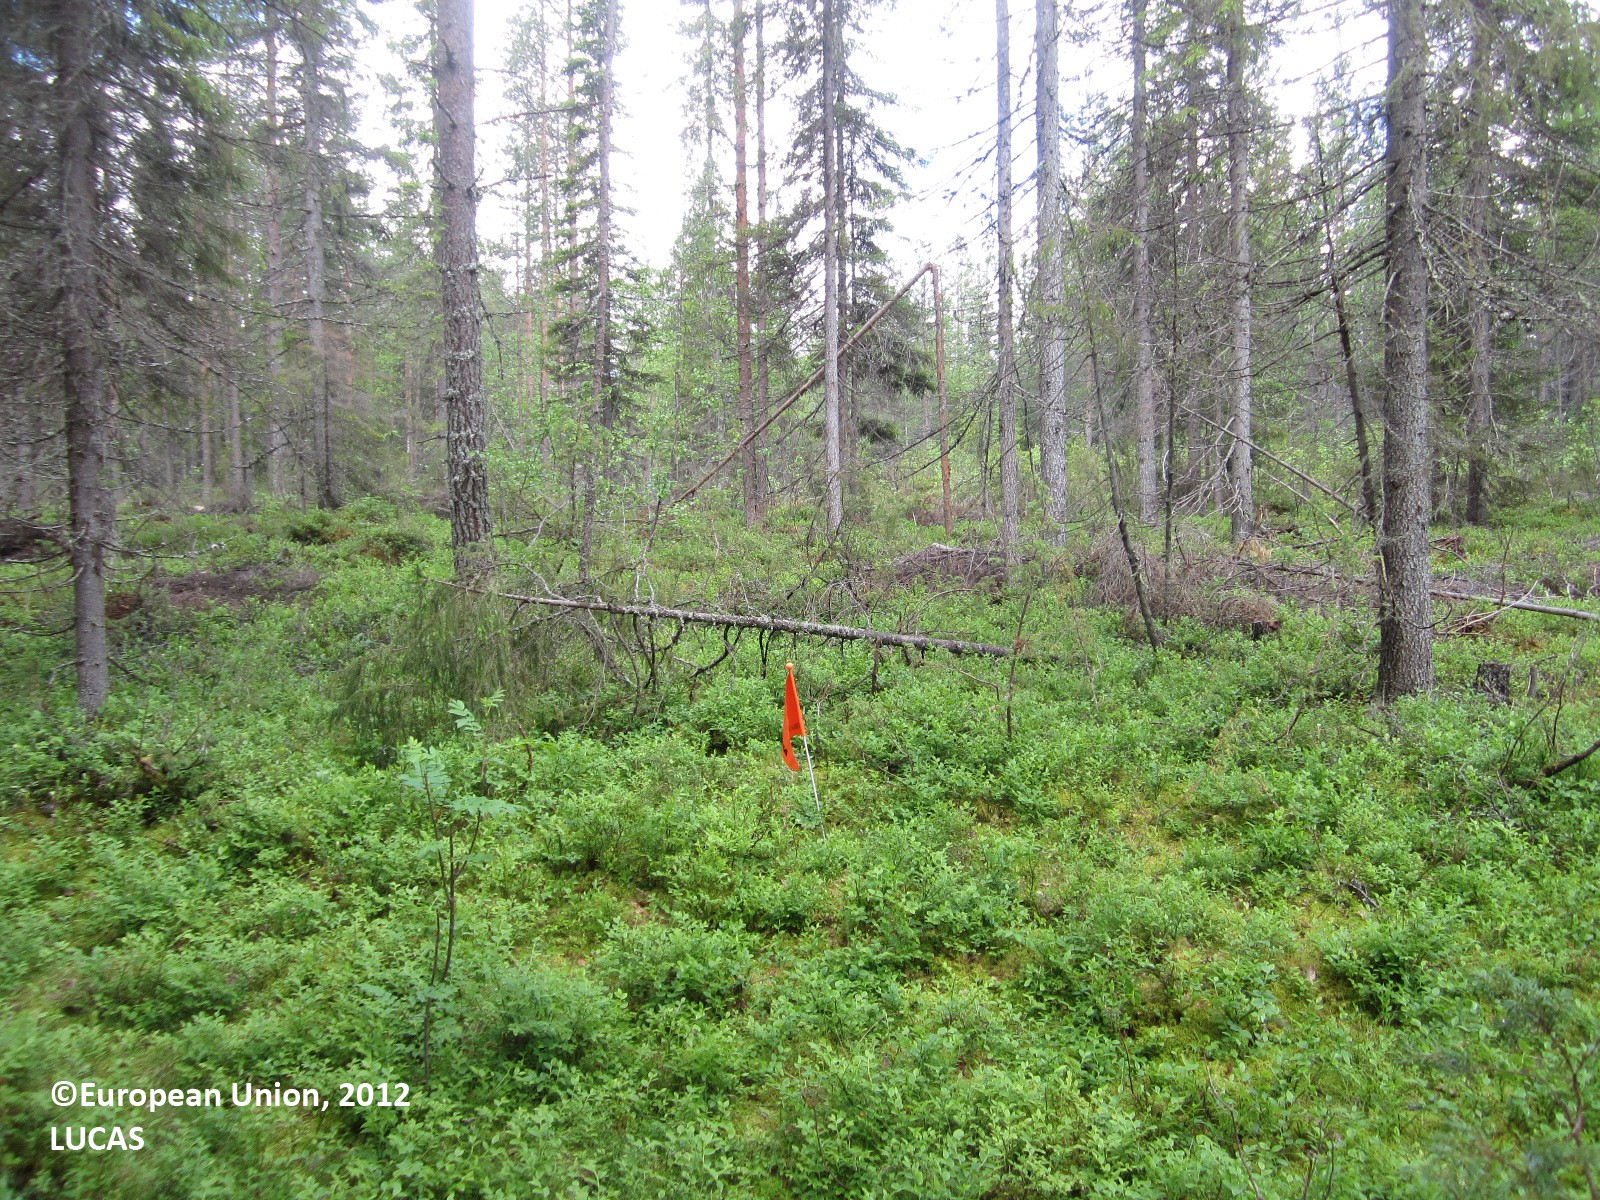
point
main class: Woodland
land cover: Spruce dominated coniferous woodland
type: boreal forest
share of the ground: > 75 %
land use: Forestry
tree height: > 5 m
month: June
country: FI
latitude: 64.4603
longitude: 29.6574
